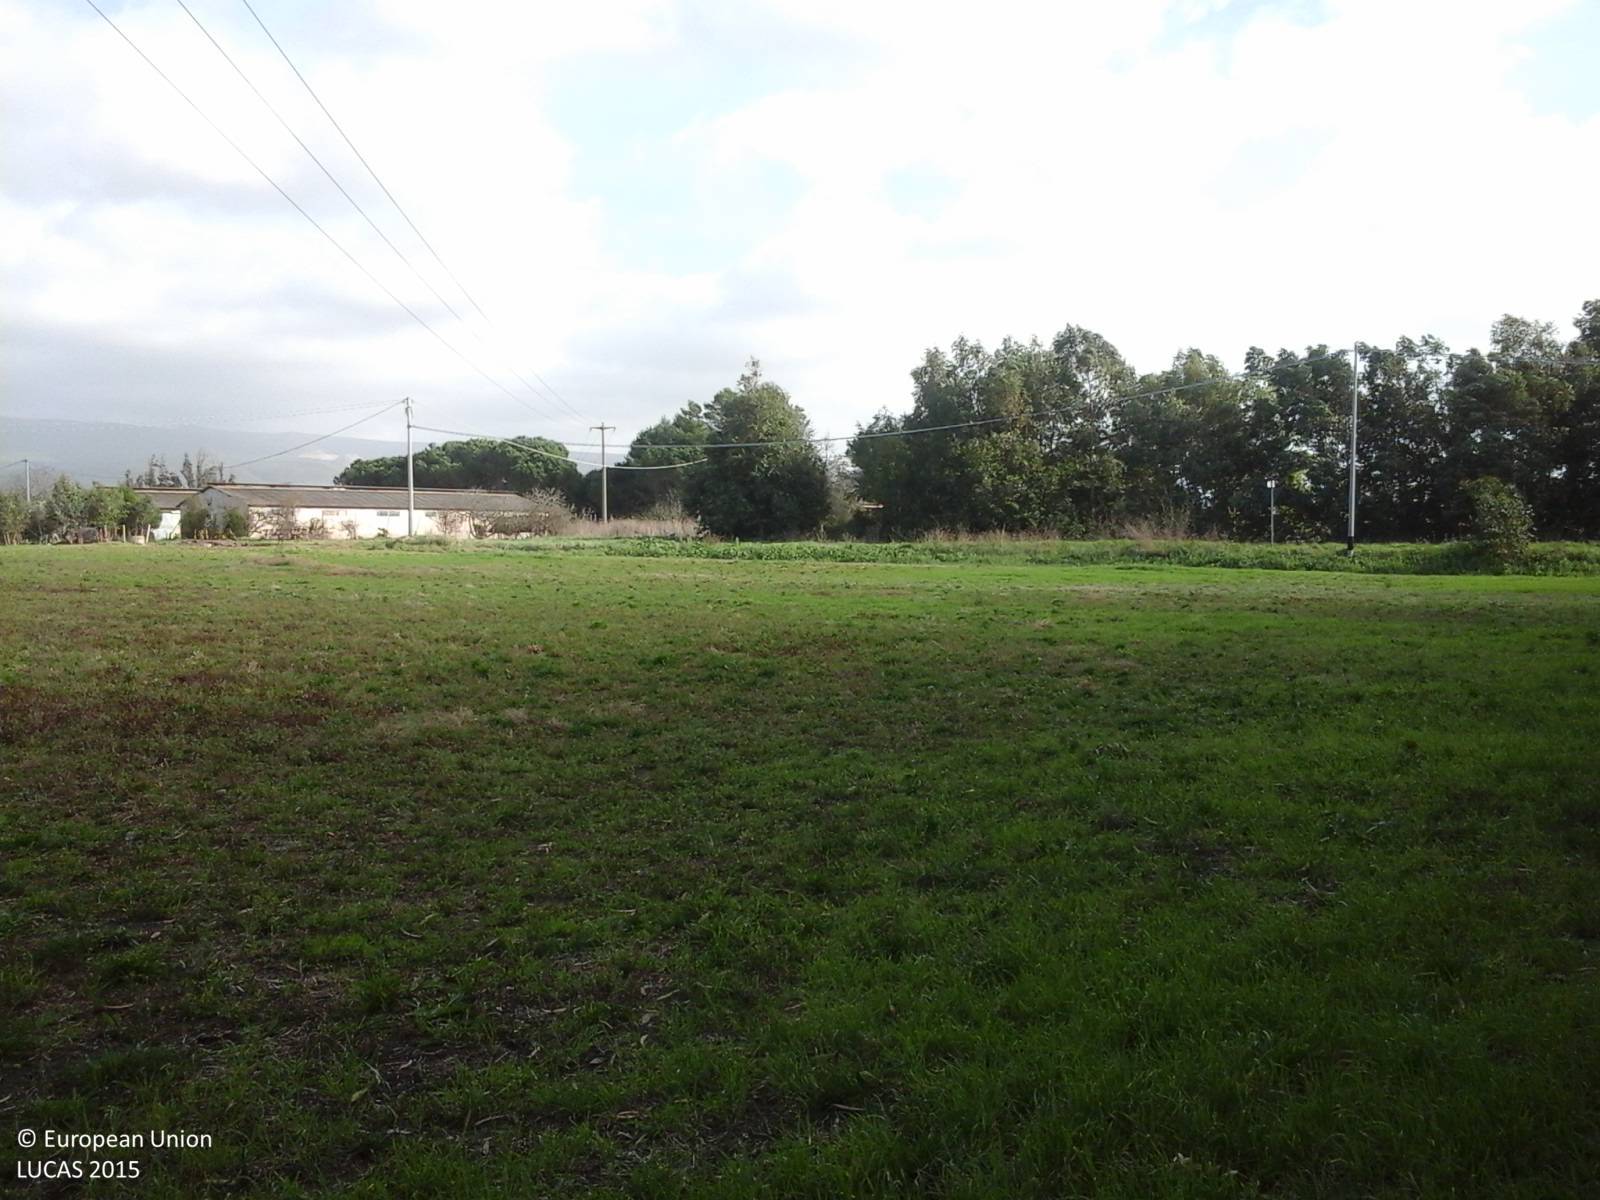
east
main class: Woodland
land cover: Broadleaved woodland
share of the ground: > 75 %
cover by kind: broadleaved forest trees 100 %
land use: Residential
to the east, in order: Broadleaved woodland; Fences; Grassland without tree/shrub cover; Electric lines; Grass margins; Paved roads, cycling and walking lanes; Grass margins; Broadleaved woodland; Temporary grasslands; Tracks; Grass margins; Ditches and canals; Fences; Electric lines; Broadleaved woodland; Artificial constructions in urban areas; Other fruit trees and berries; Fences; Grassland without tree/shrub cover; Vineyards
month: January
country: IT
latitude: 39.7328
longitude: 8.6426
